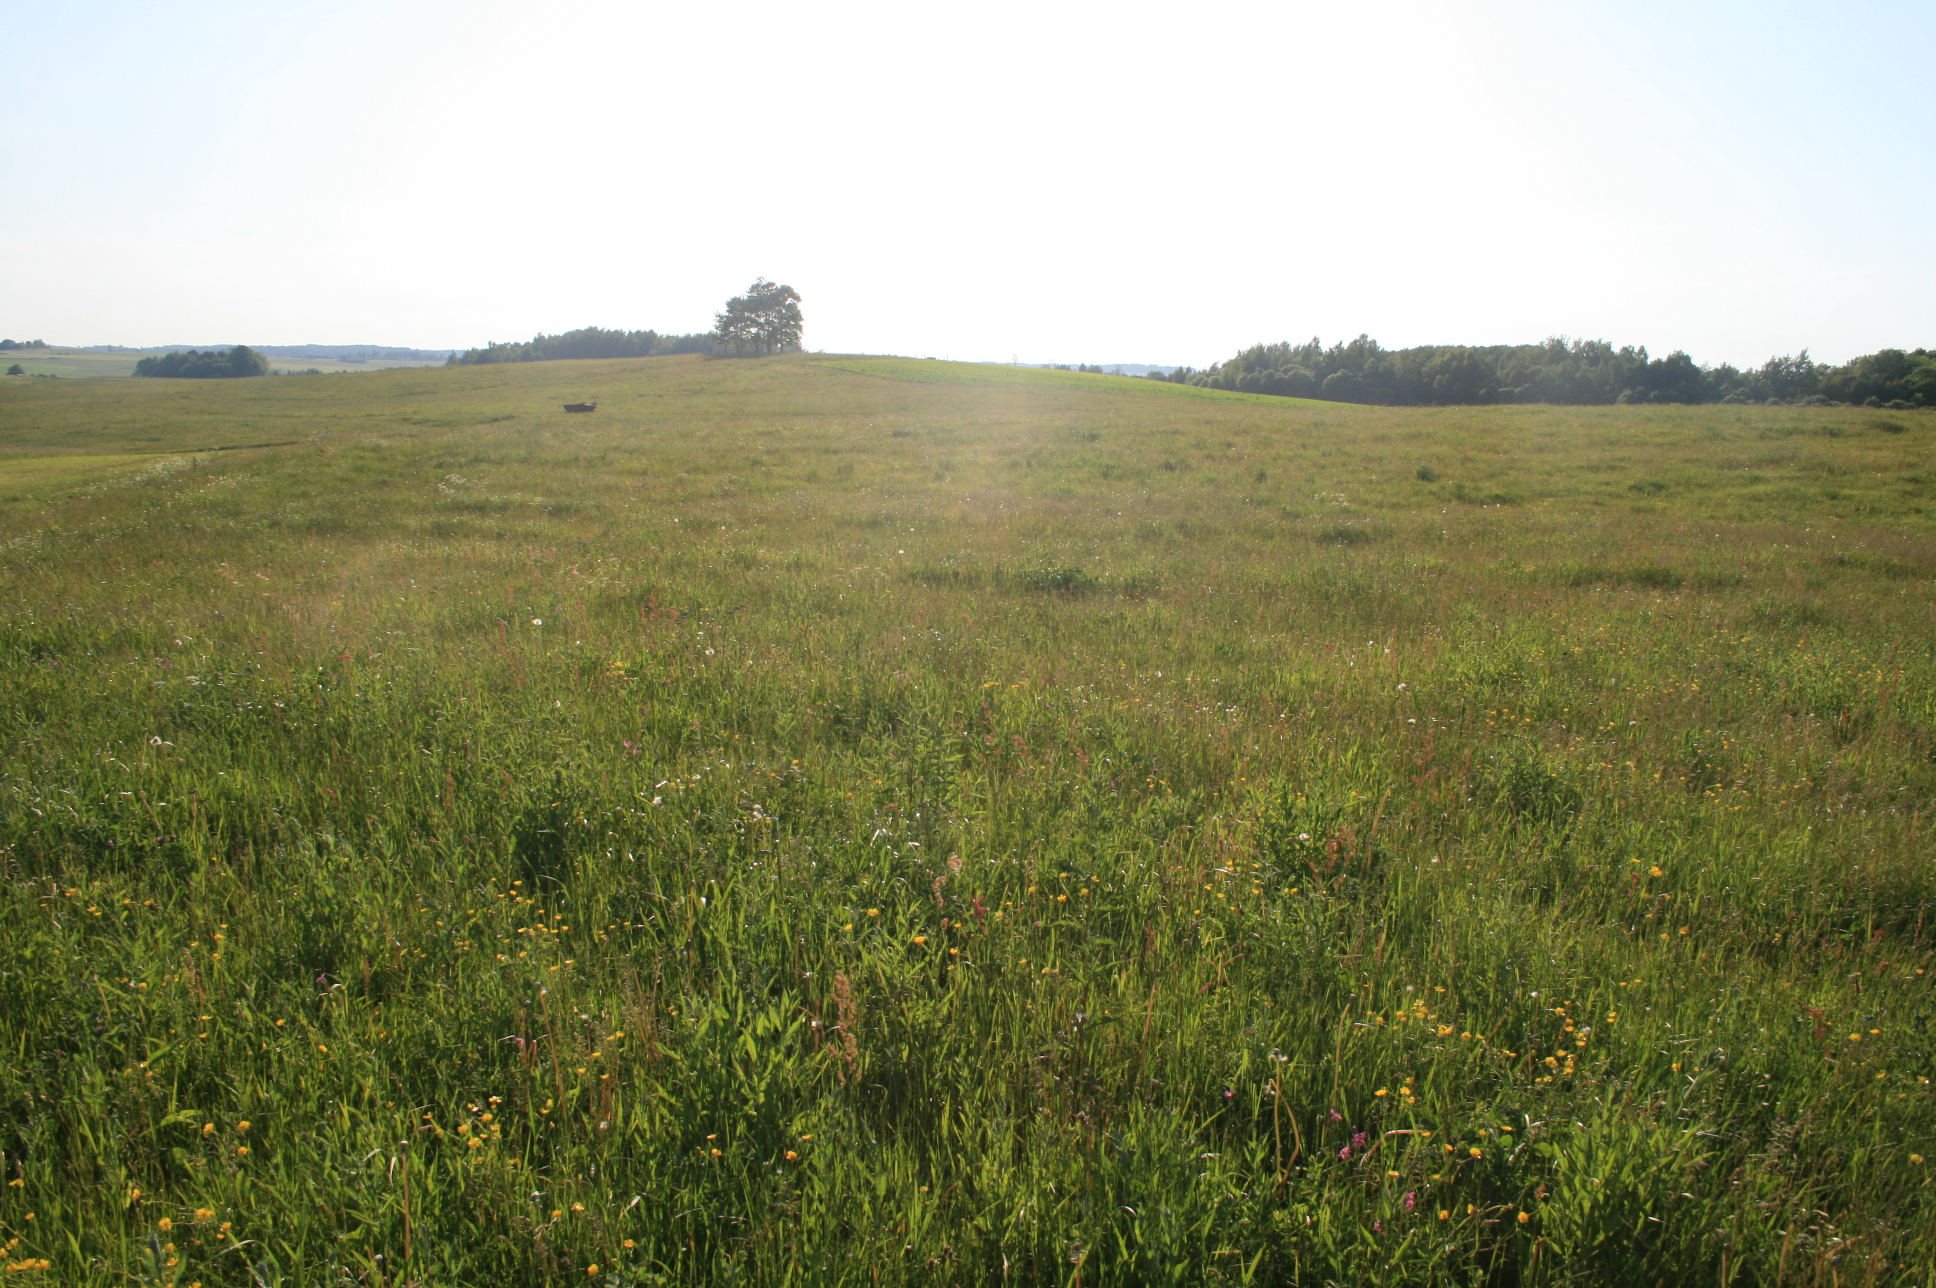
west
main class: Grassland
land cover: Grassland without tree/shrub cover
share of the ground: > 75 %
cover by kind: herbaceous plants 100 %
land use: Agriculture (excluding fallow land and kitchen gardens)
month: June
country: LT
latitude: 55.6739
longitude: 22.2201
